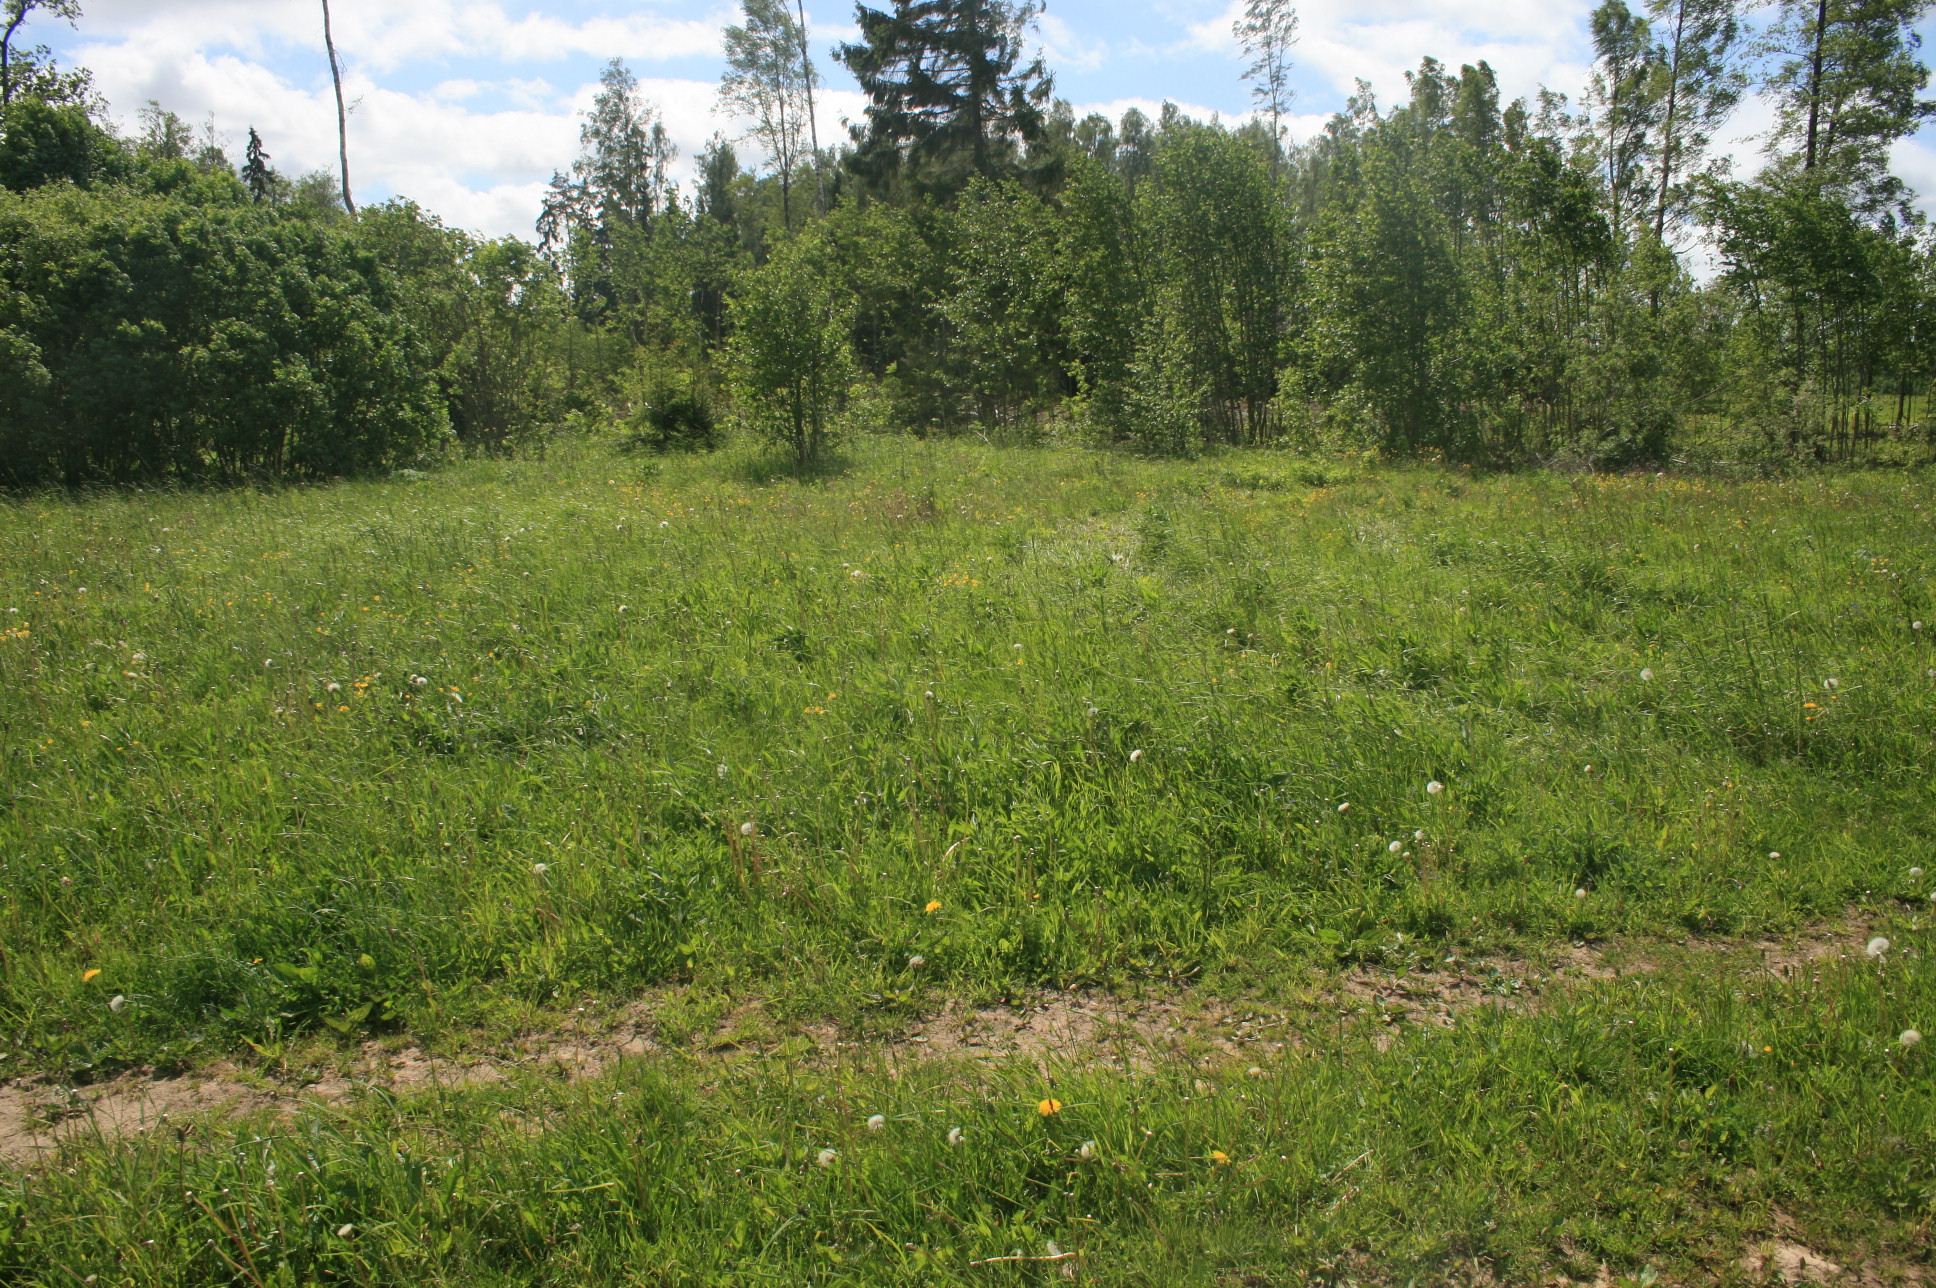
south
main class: Grassland
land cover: Grassland without tree/shrub cover
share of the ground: > 75 %
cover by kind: herbaceous plants 95 %, unconsolidated bare surface 5 %
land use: Agriculture (excluding fallow land and kitchen gardens)
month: June
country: LT
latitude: 56.0948
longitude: 22.3859
